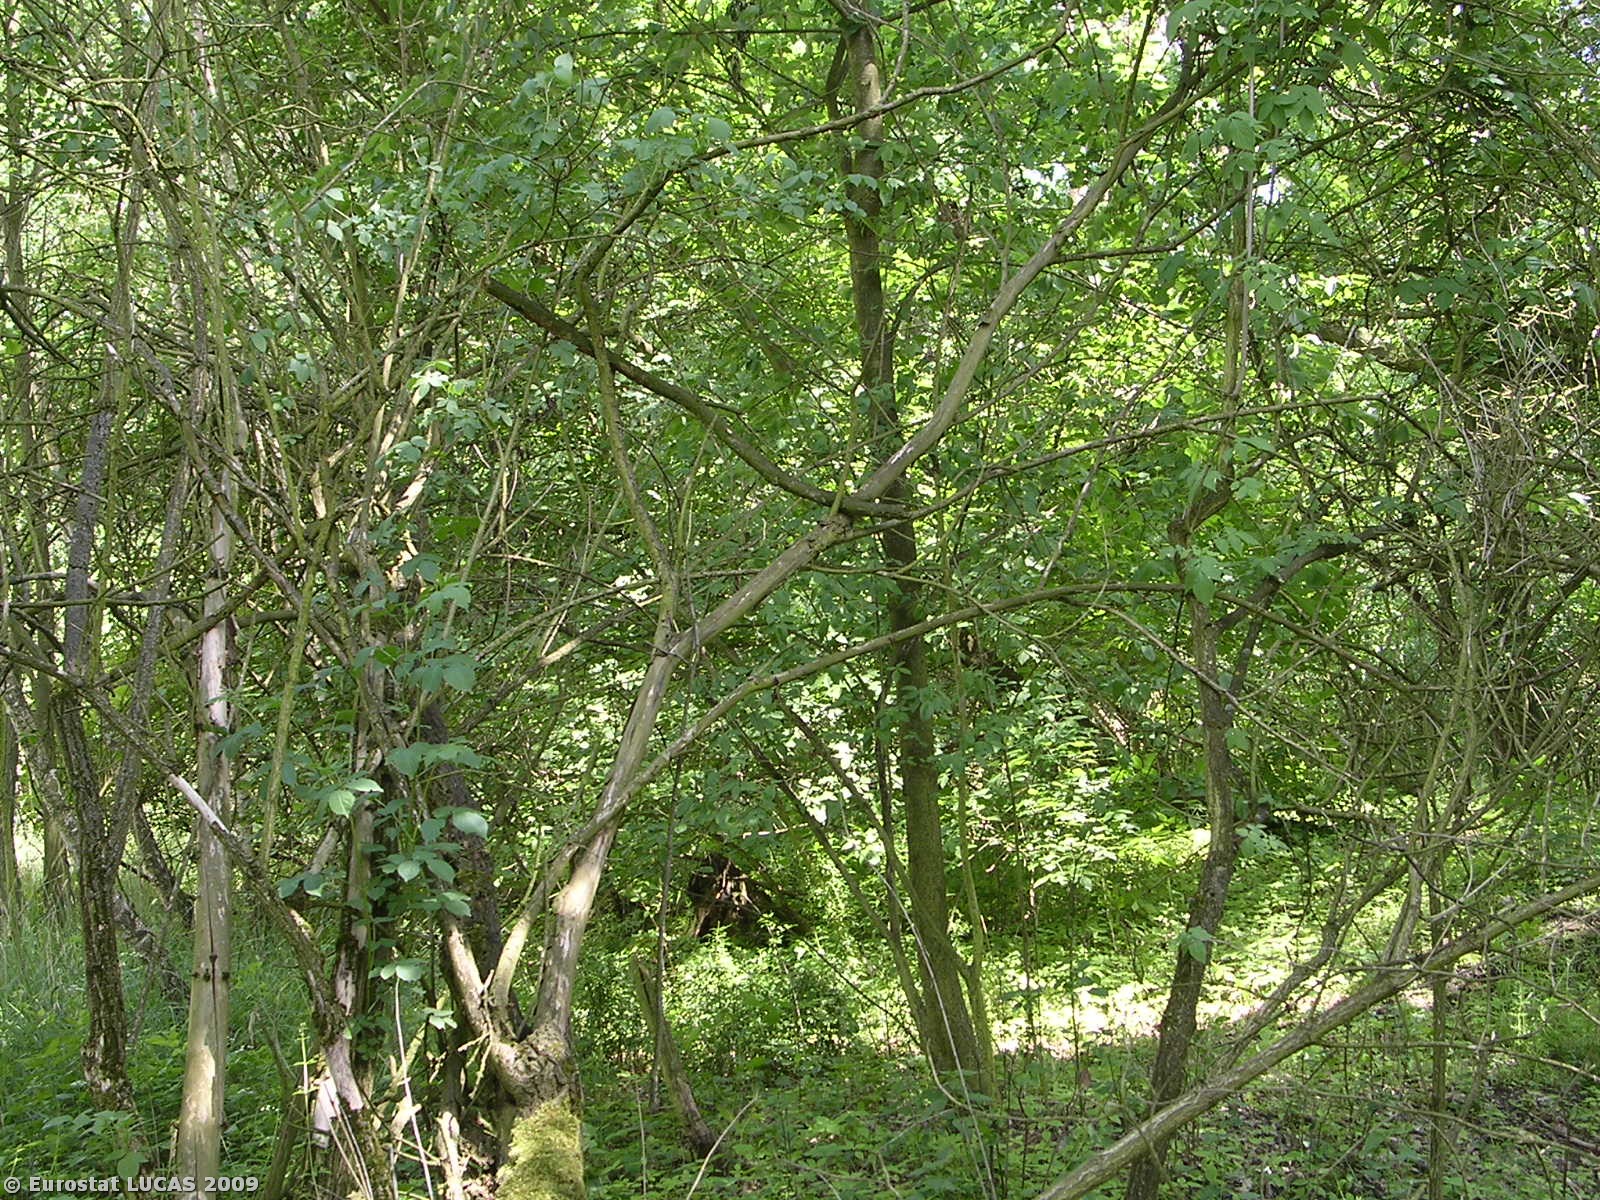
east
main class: Woodland
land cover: Broadleaved woodland
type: hemiboreal forest and nemoral coniferous forest and mixed broadleaved-coniferous forest
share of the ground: > 75 %
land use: Unused
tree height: > 5 m
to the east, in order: Broadleaved woodland; Mixed woodland; Artificial constructions in urban areas; Grassland with sparse tree/shrub cover; Grassland without tree/shrub cover
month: May
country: CZ
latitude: 50.2400
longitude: 14.9241
